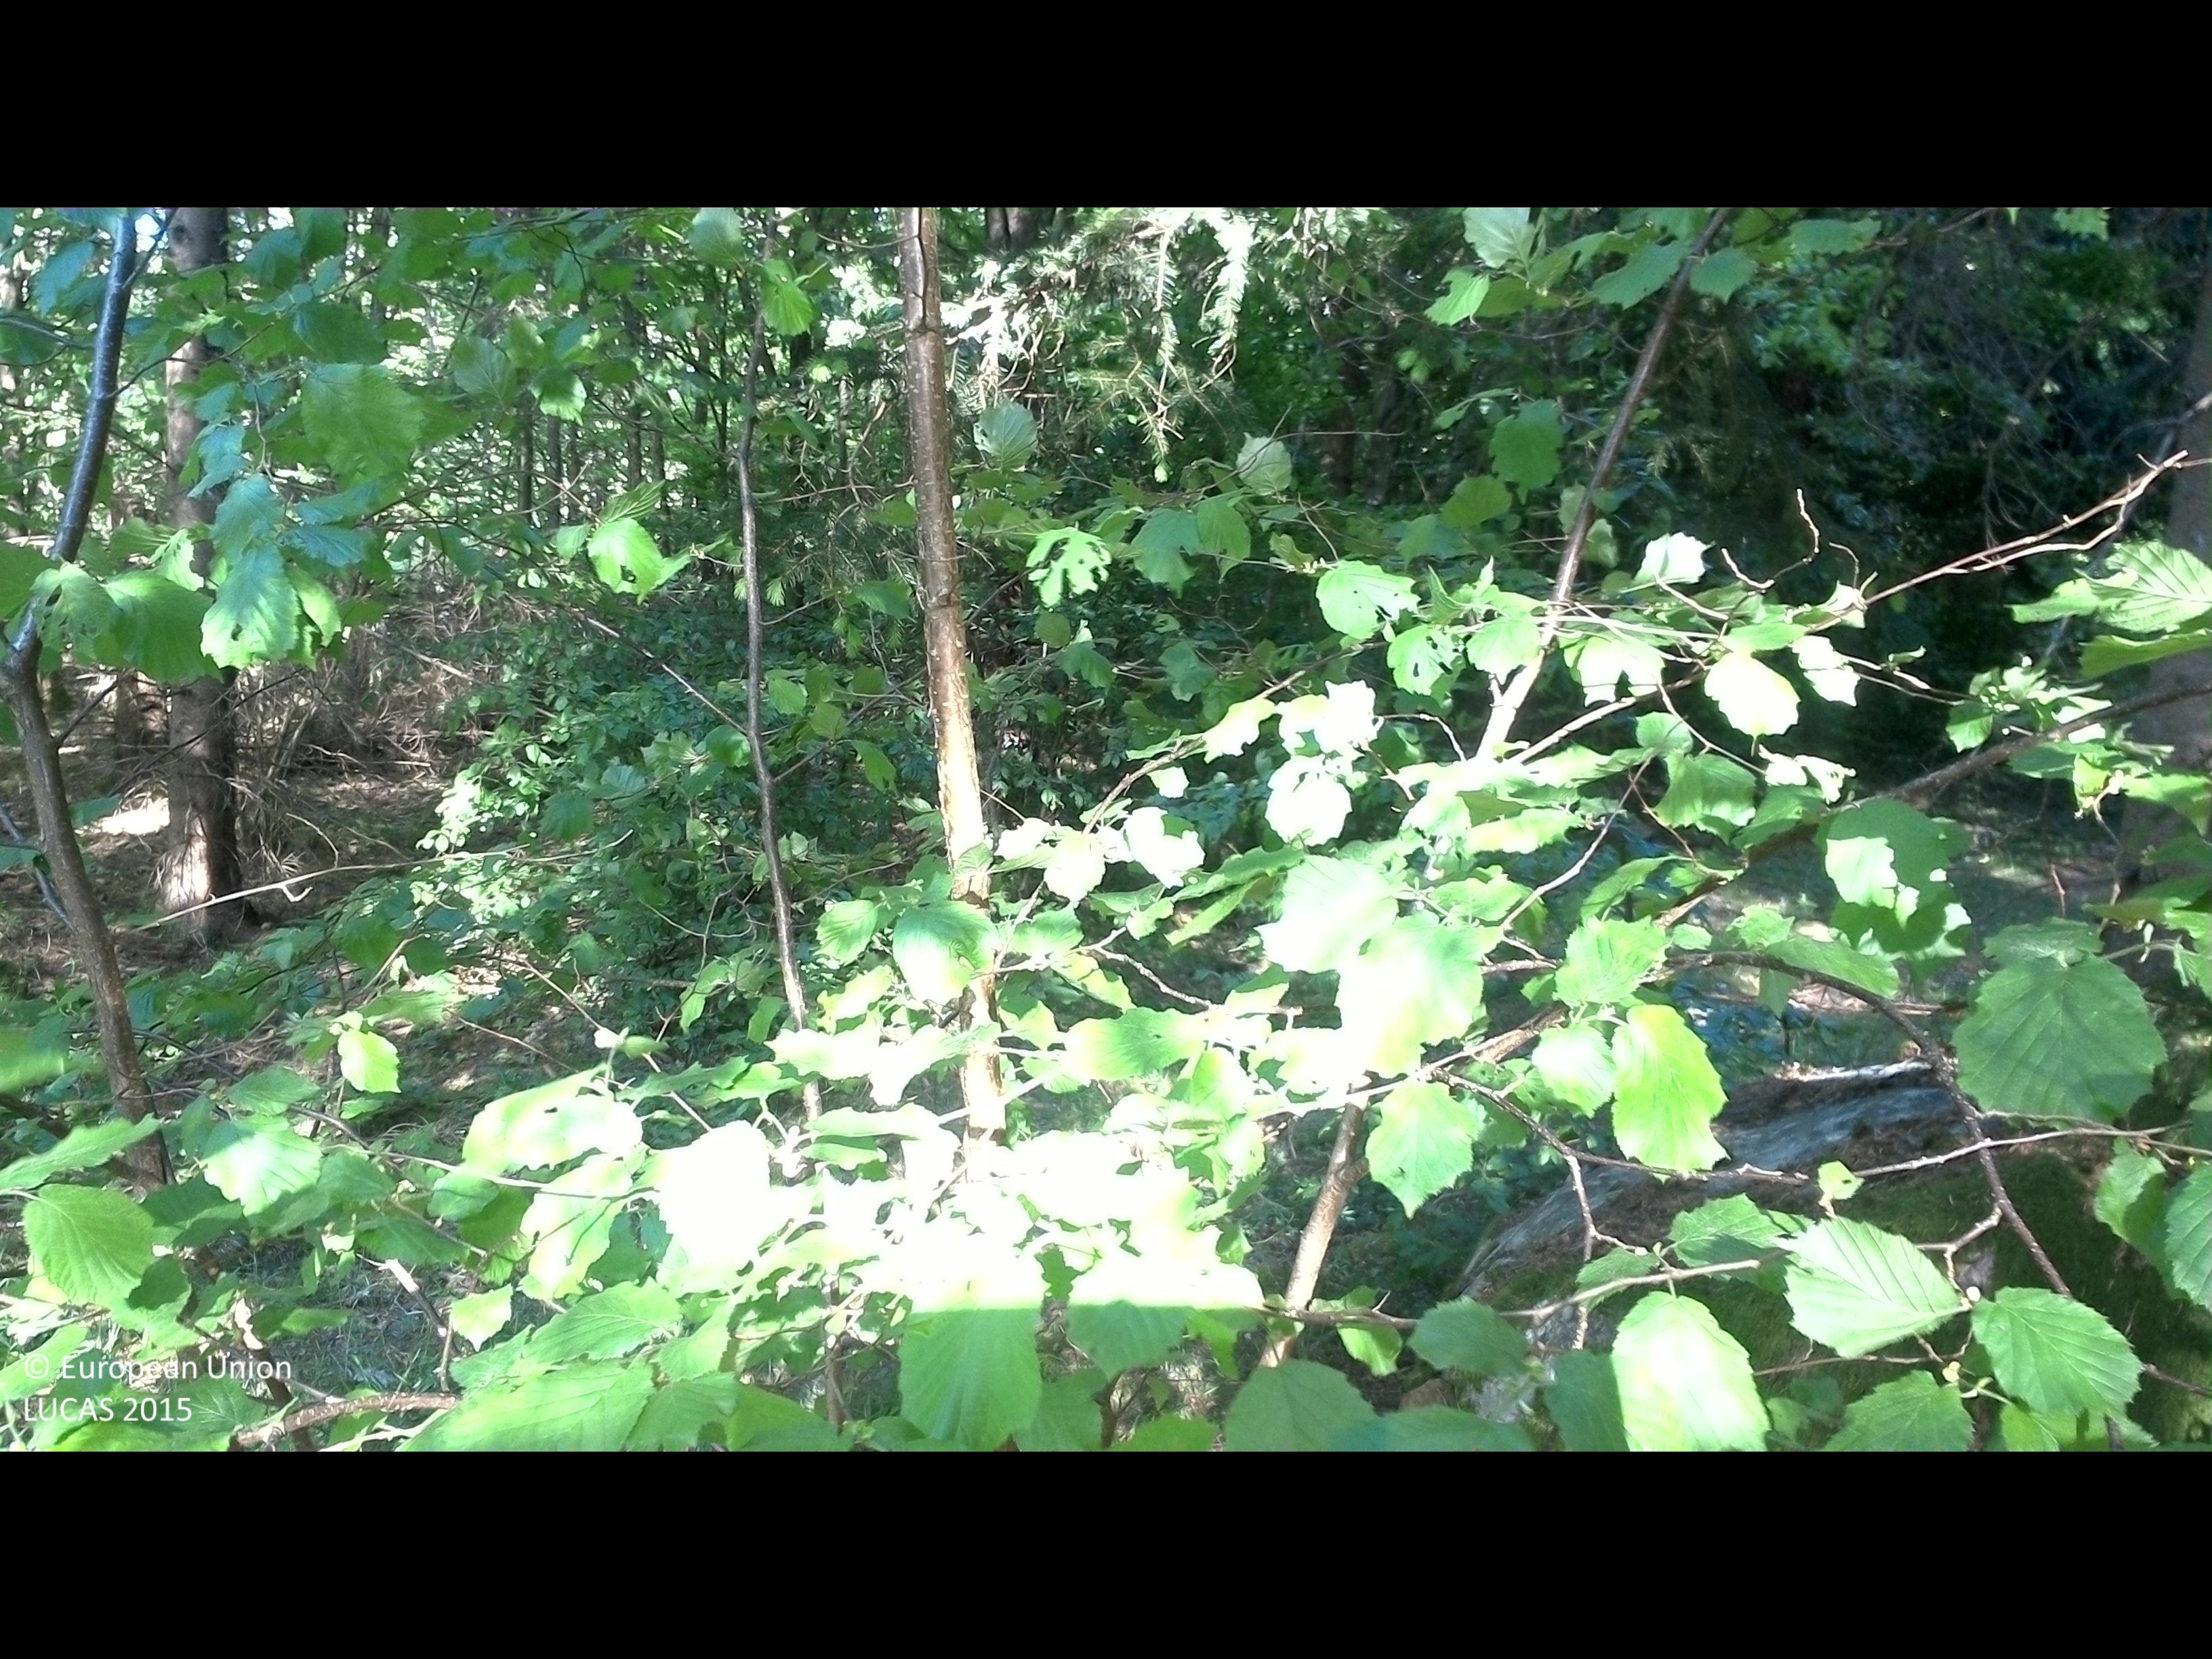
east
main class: Woodland
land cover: Spruce dominated mixed woodland
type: boreal forest
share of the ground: > 75 %
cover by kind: coniferous forest trees 60 %, broadleaved forest trees 20 %, herbaceous plants 20 %
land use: Forestry
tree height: > 5 m
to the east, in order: Spruce dominated mixed woodland; Tracks; Broadleaved woodland; Electric lines; Broadleaved woodland; Dry stone walls; Broadleaved woodland; Shrubland with sparse tree cover
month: June
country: SE
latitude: 56.5955
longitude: 15.8464
